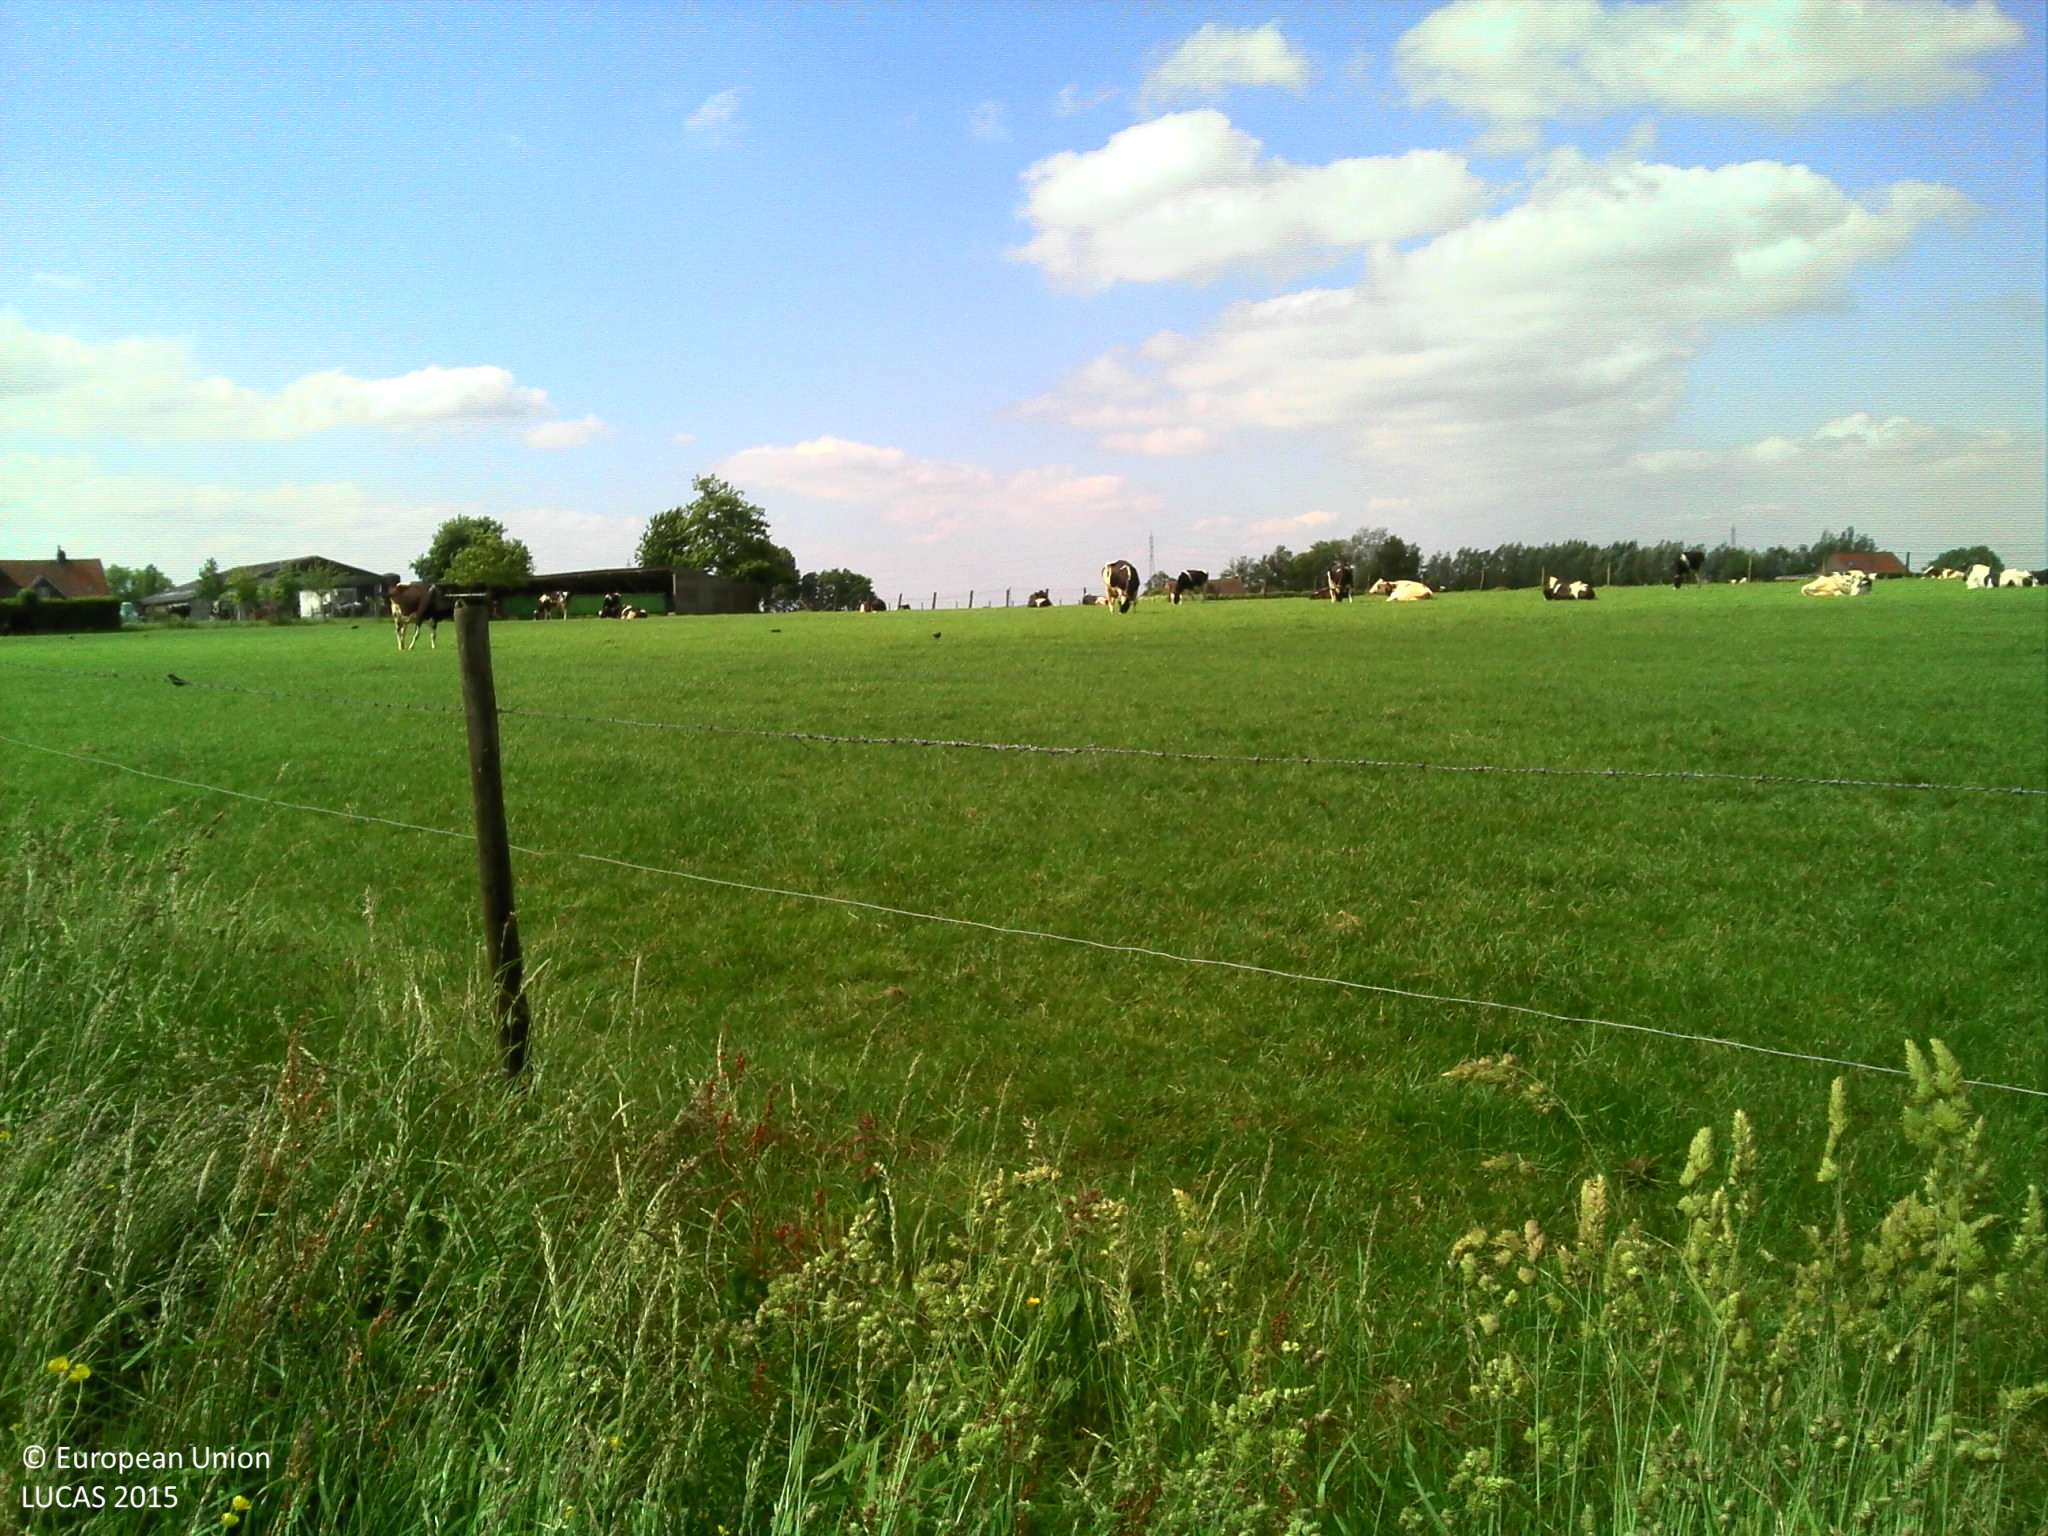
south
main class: Grassland
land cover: Grassland without tree/shrub cover
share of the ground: > 75 %
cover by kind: herbaceous plants 100 %
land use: Agriculture (excluding fallow land and kitchen gardens)
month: June
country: BE
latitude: 50.8416
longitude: 3.1028
